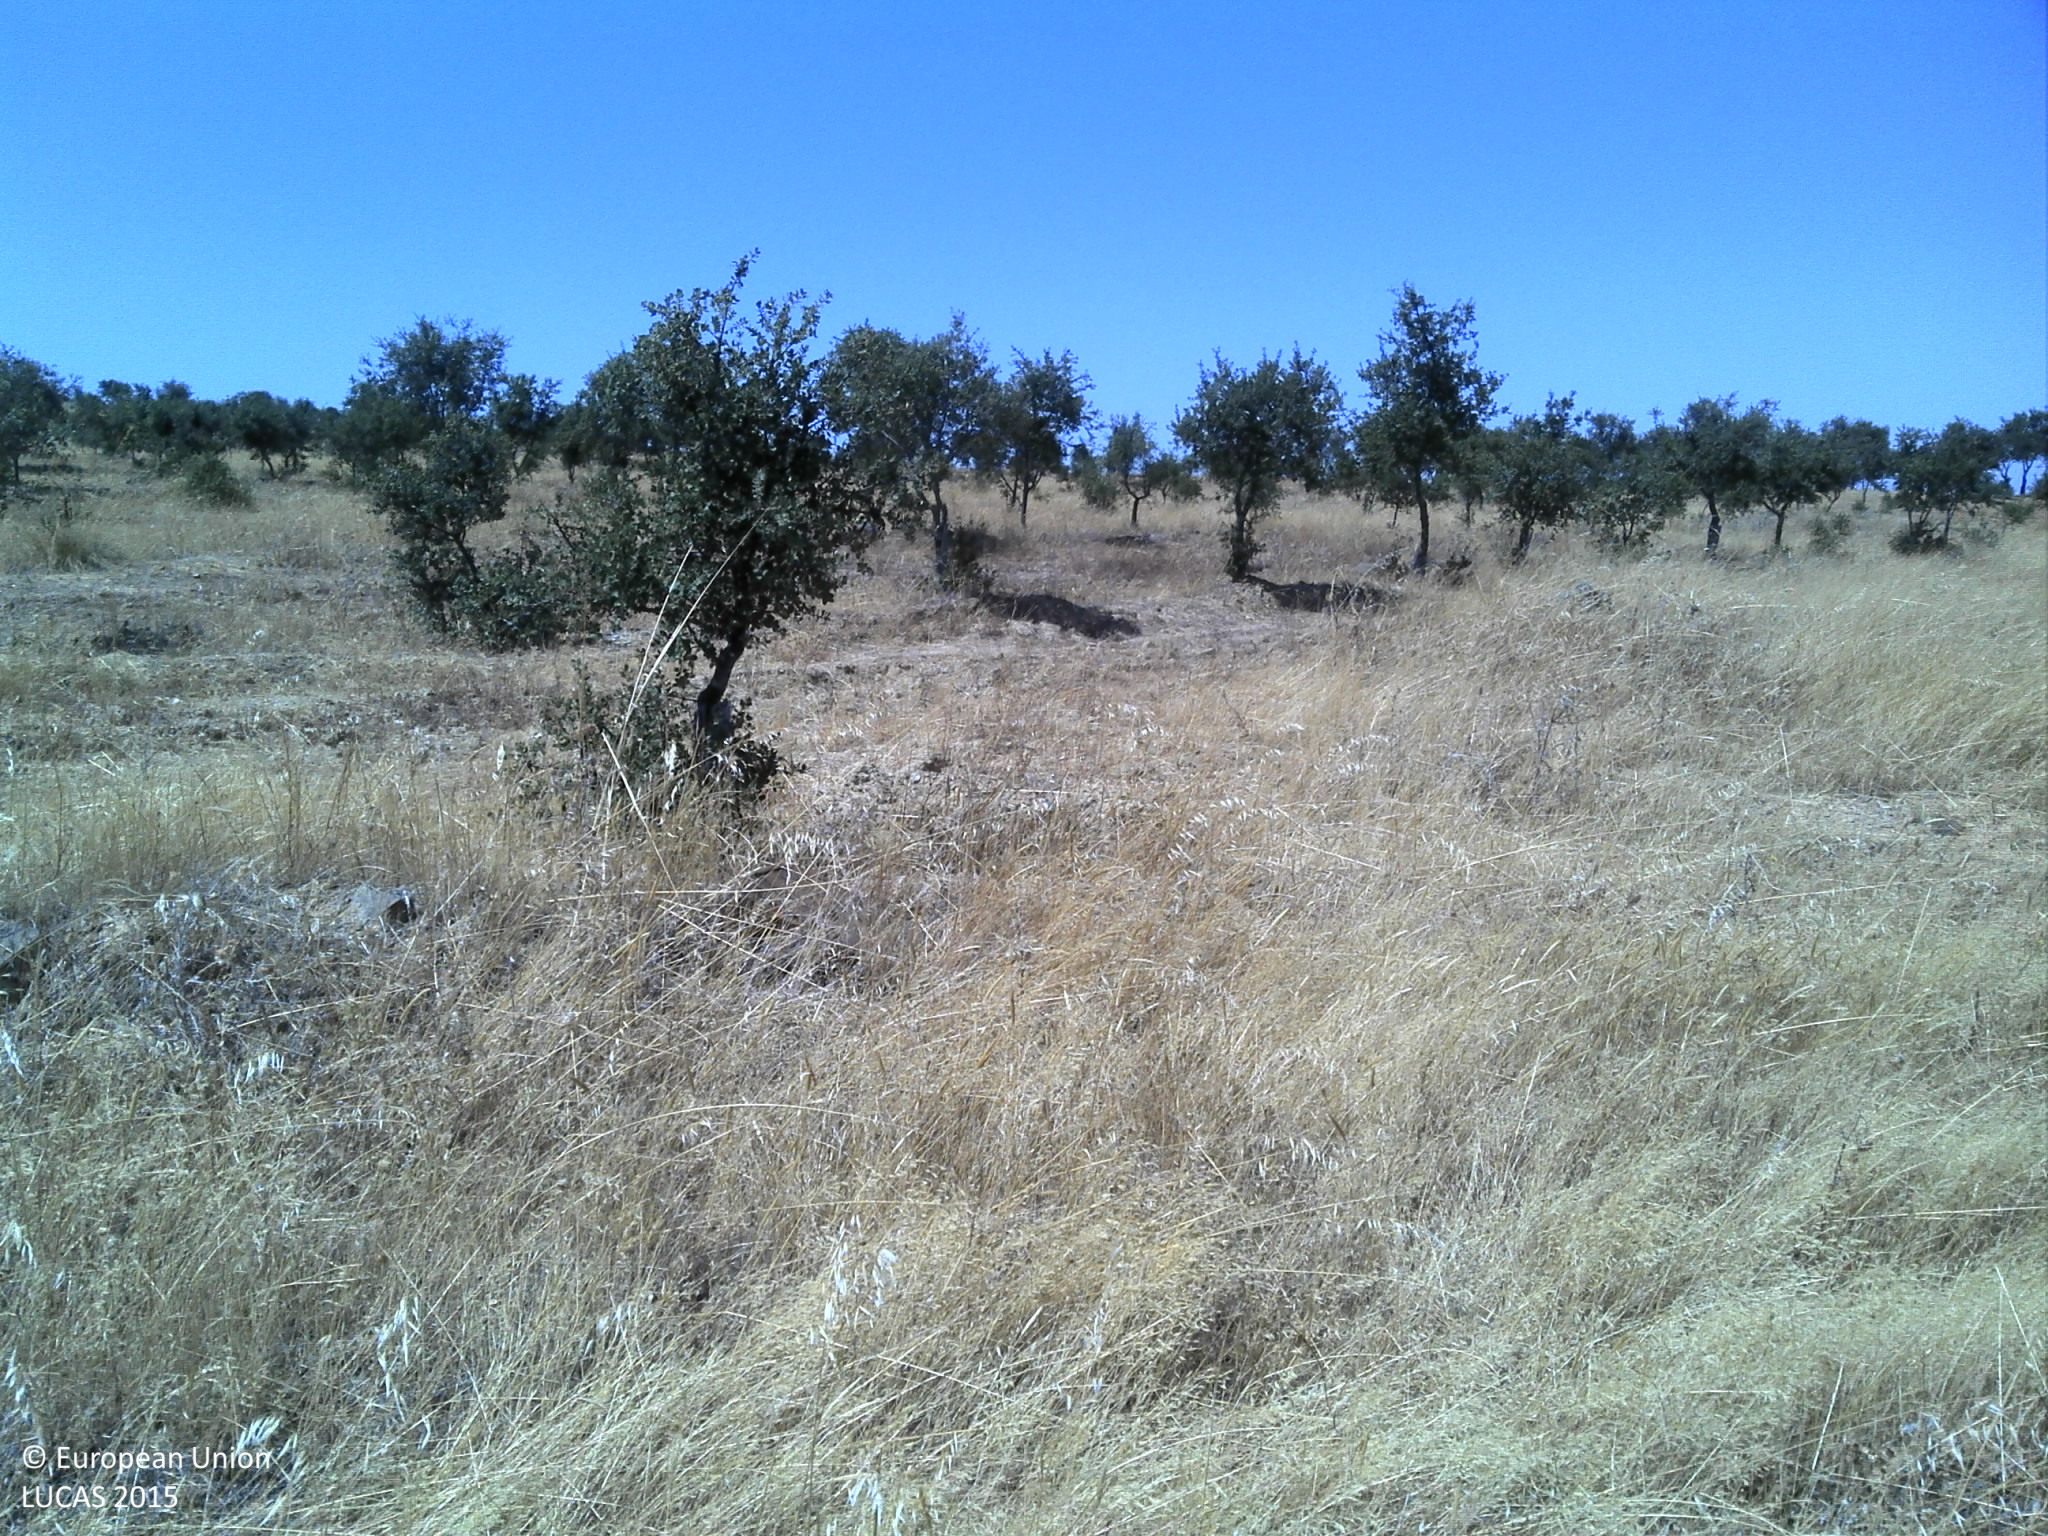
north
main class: Woodland
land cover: Broadleaved woodland
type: broadleaved evergreen forest
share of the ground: 10 - 25 %
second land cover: Grassland without tree/shrub cover
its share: 50 - 75 %
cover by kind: herbaceous plants 60 %, broadleaved forest trees 20 %, unconsolidated bare surface 15 %, consolidated bare surface 5 %
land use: Forestry
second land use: Agriculture (excluding fallow land and kitchen gardens)
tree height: < 5 m
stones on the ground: < 10 %
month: July
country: PT
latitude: 37.6329
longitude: -7.9602
